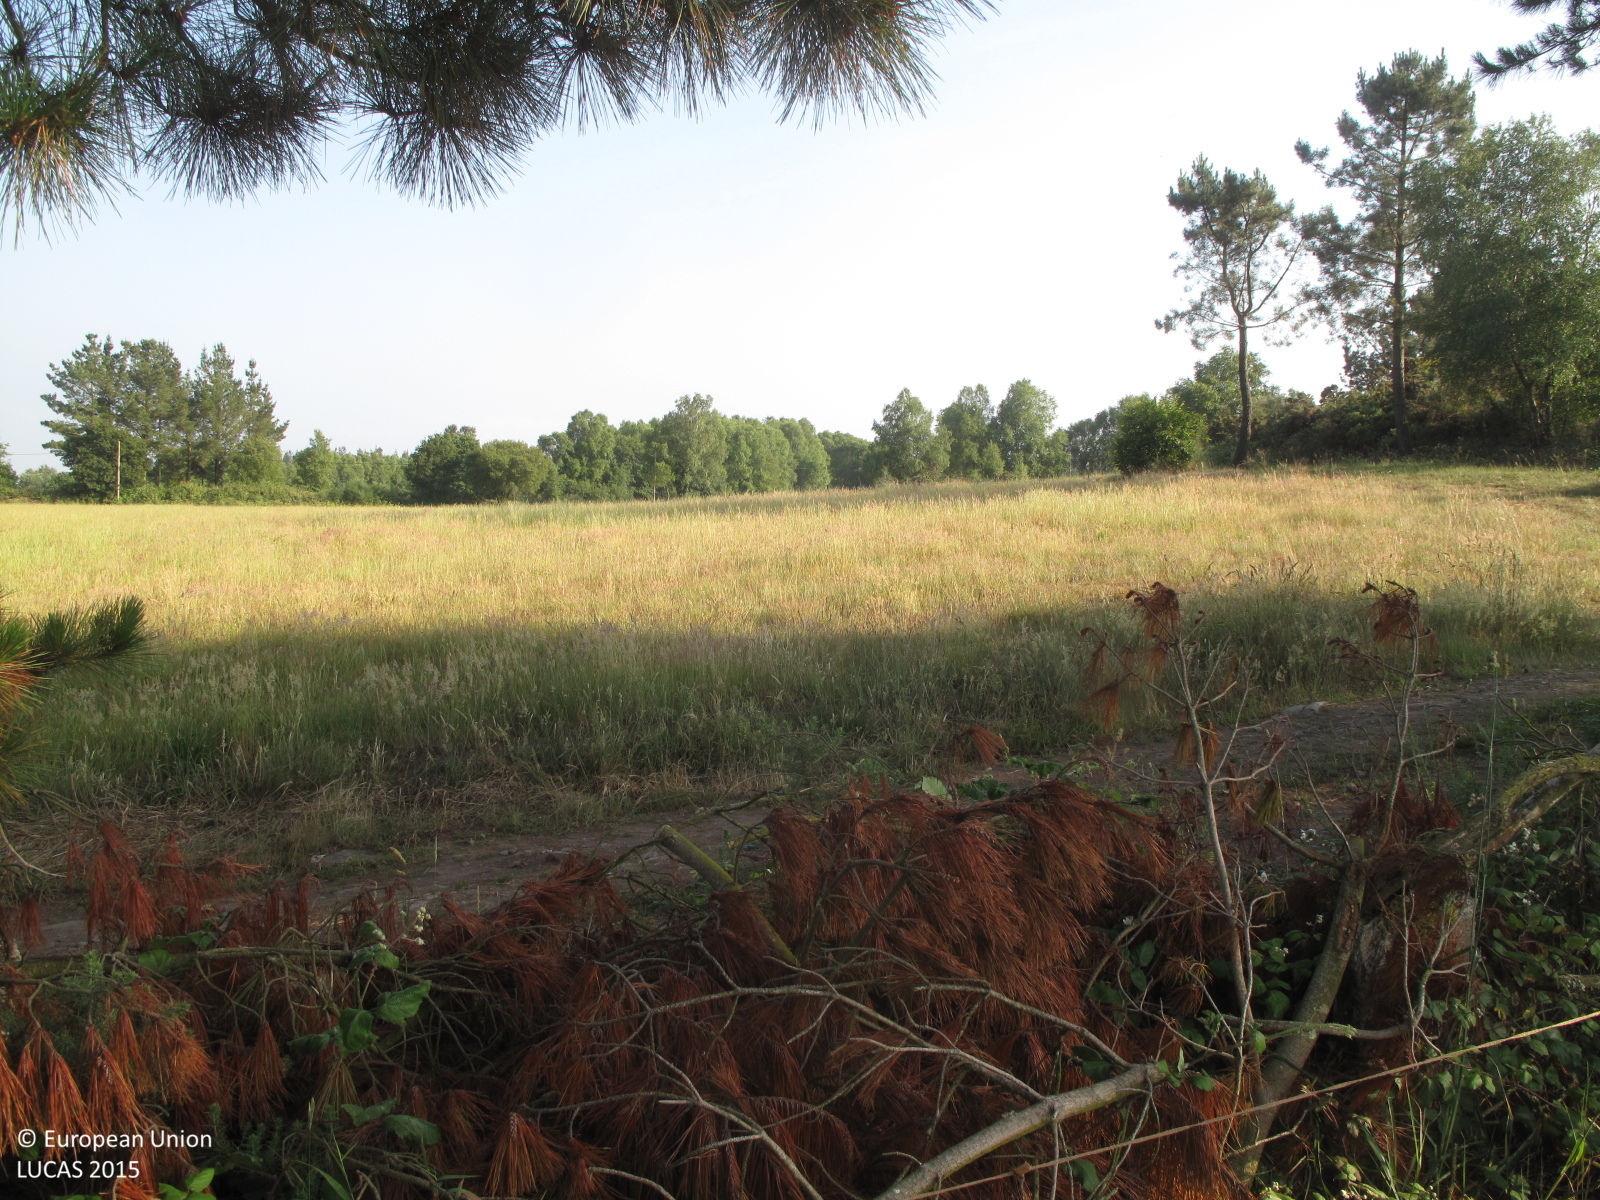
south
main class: Grassland
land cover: Grassland without tree/shrub cover
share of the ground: > 75 %
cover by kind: herbaceous plants 100 %
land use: Agriculture (excluding fallow land and kitchen gardens)
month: June
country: ES
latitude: 43.0764
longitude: -7.8839
